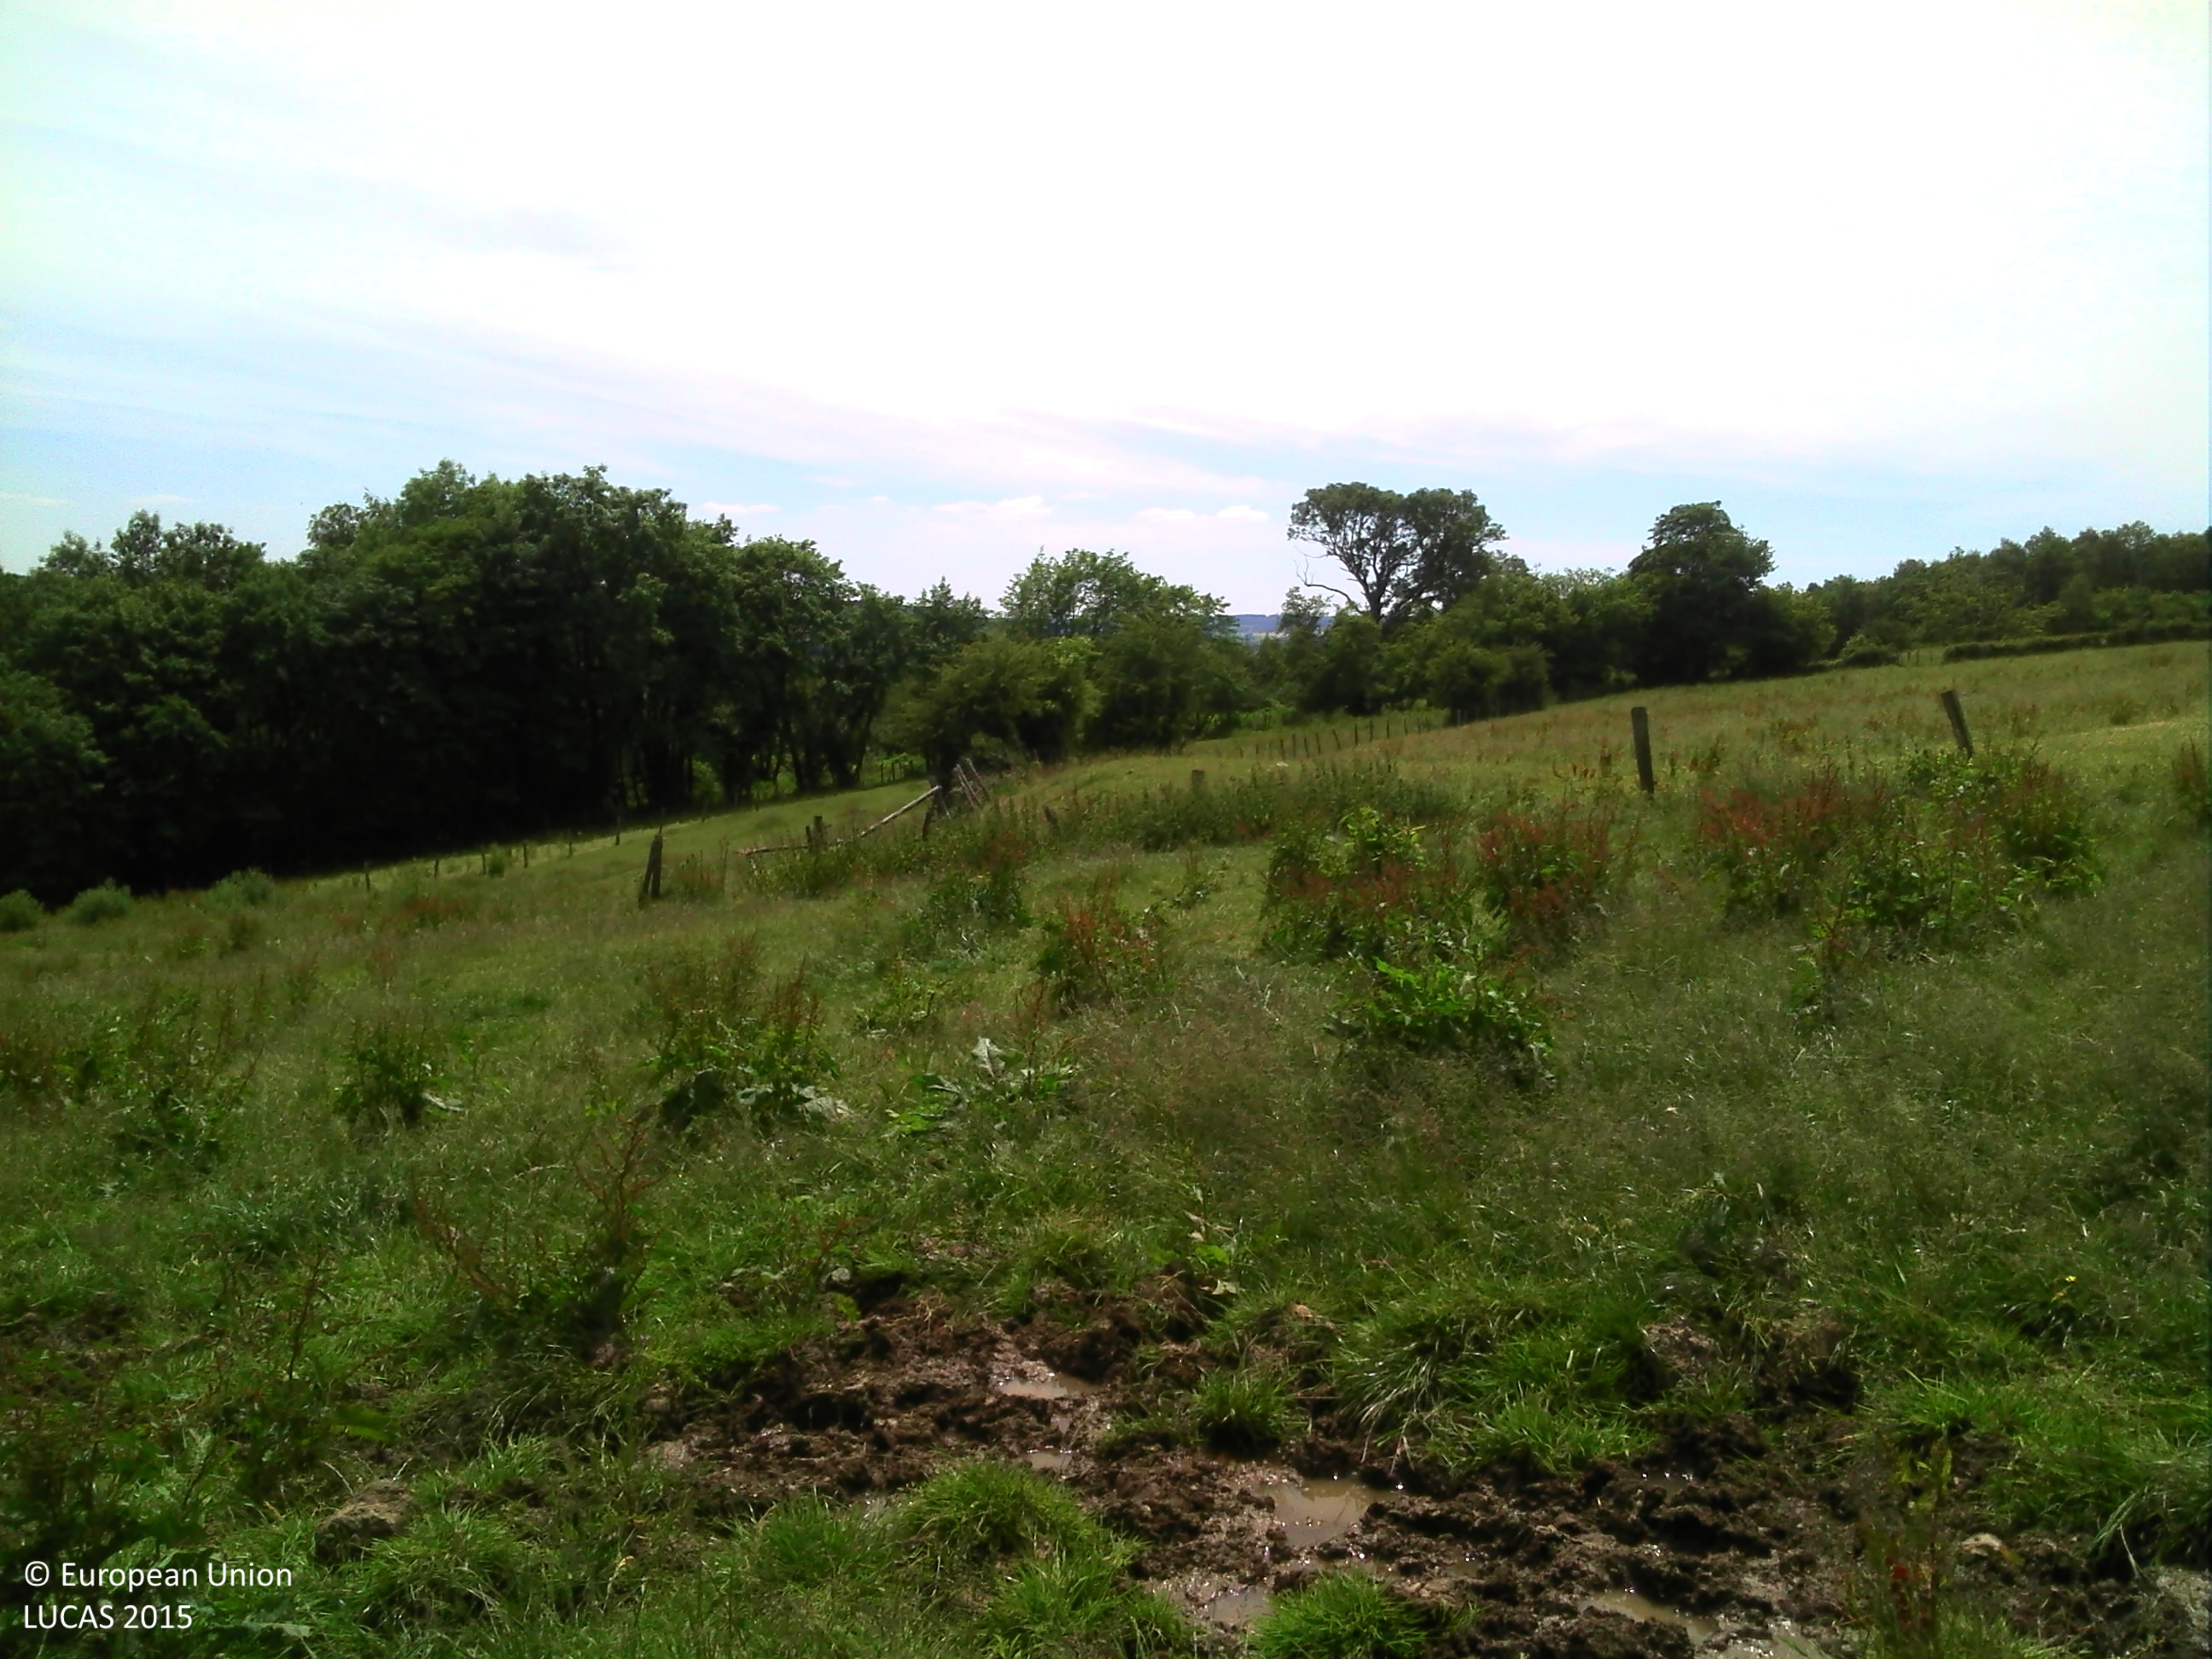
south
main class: Grassland
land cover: Grassland without tree/shrub cover
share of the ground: > 75 %
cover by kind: herbaceous plants 100 %
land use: Agriculture (excluding fallow land and kitchen gardens)
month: June
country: BE
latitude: 50.4337
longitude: 5.8738
